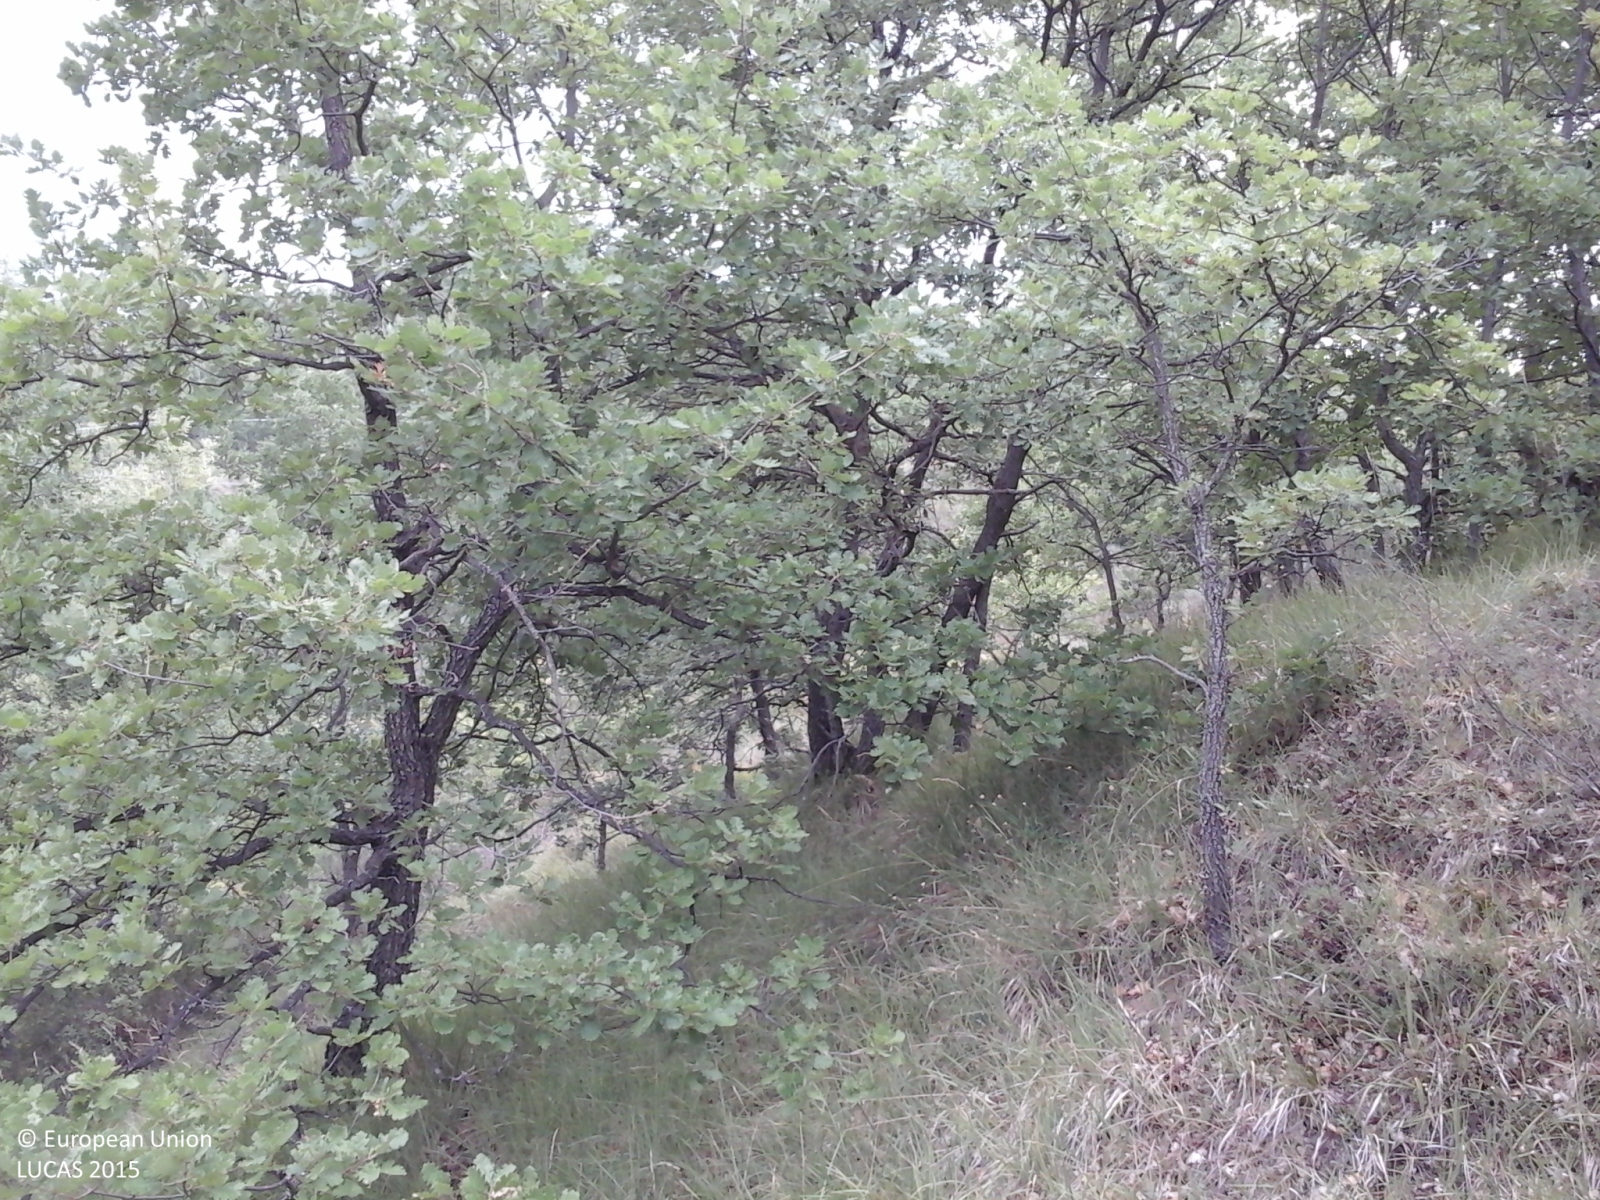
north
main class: Woodland
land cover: Broadleaved woodland
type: thermophilous deciduous forest
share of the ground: > 75 %
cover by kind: broadleaved forest trees 75 %, shrubs 20 %, herbaceous plants 5 %
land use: Semi-natural and natural areas not in use
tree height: > 5 m
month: August
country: IT
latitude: 41.7985
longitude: 14.4019
